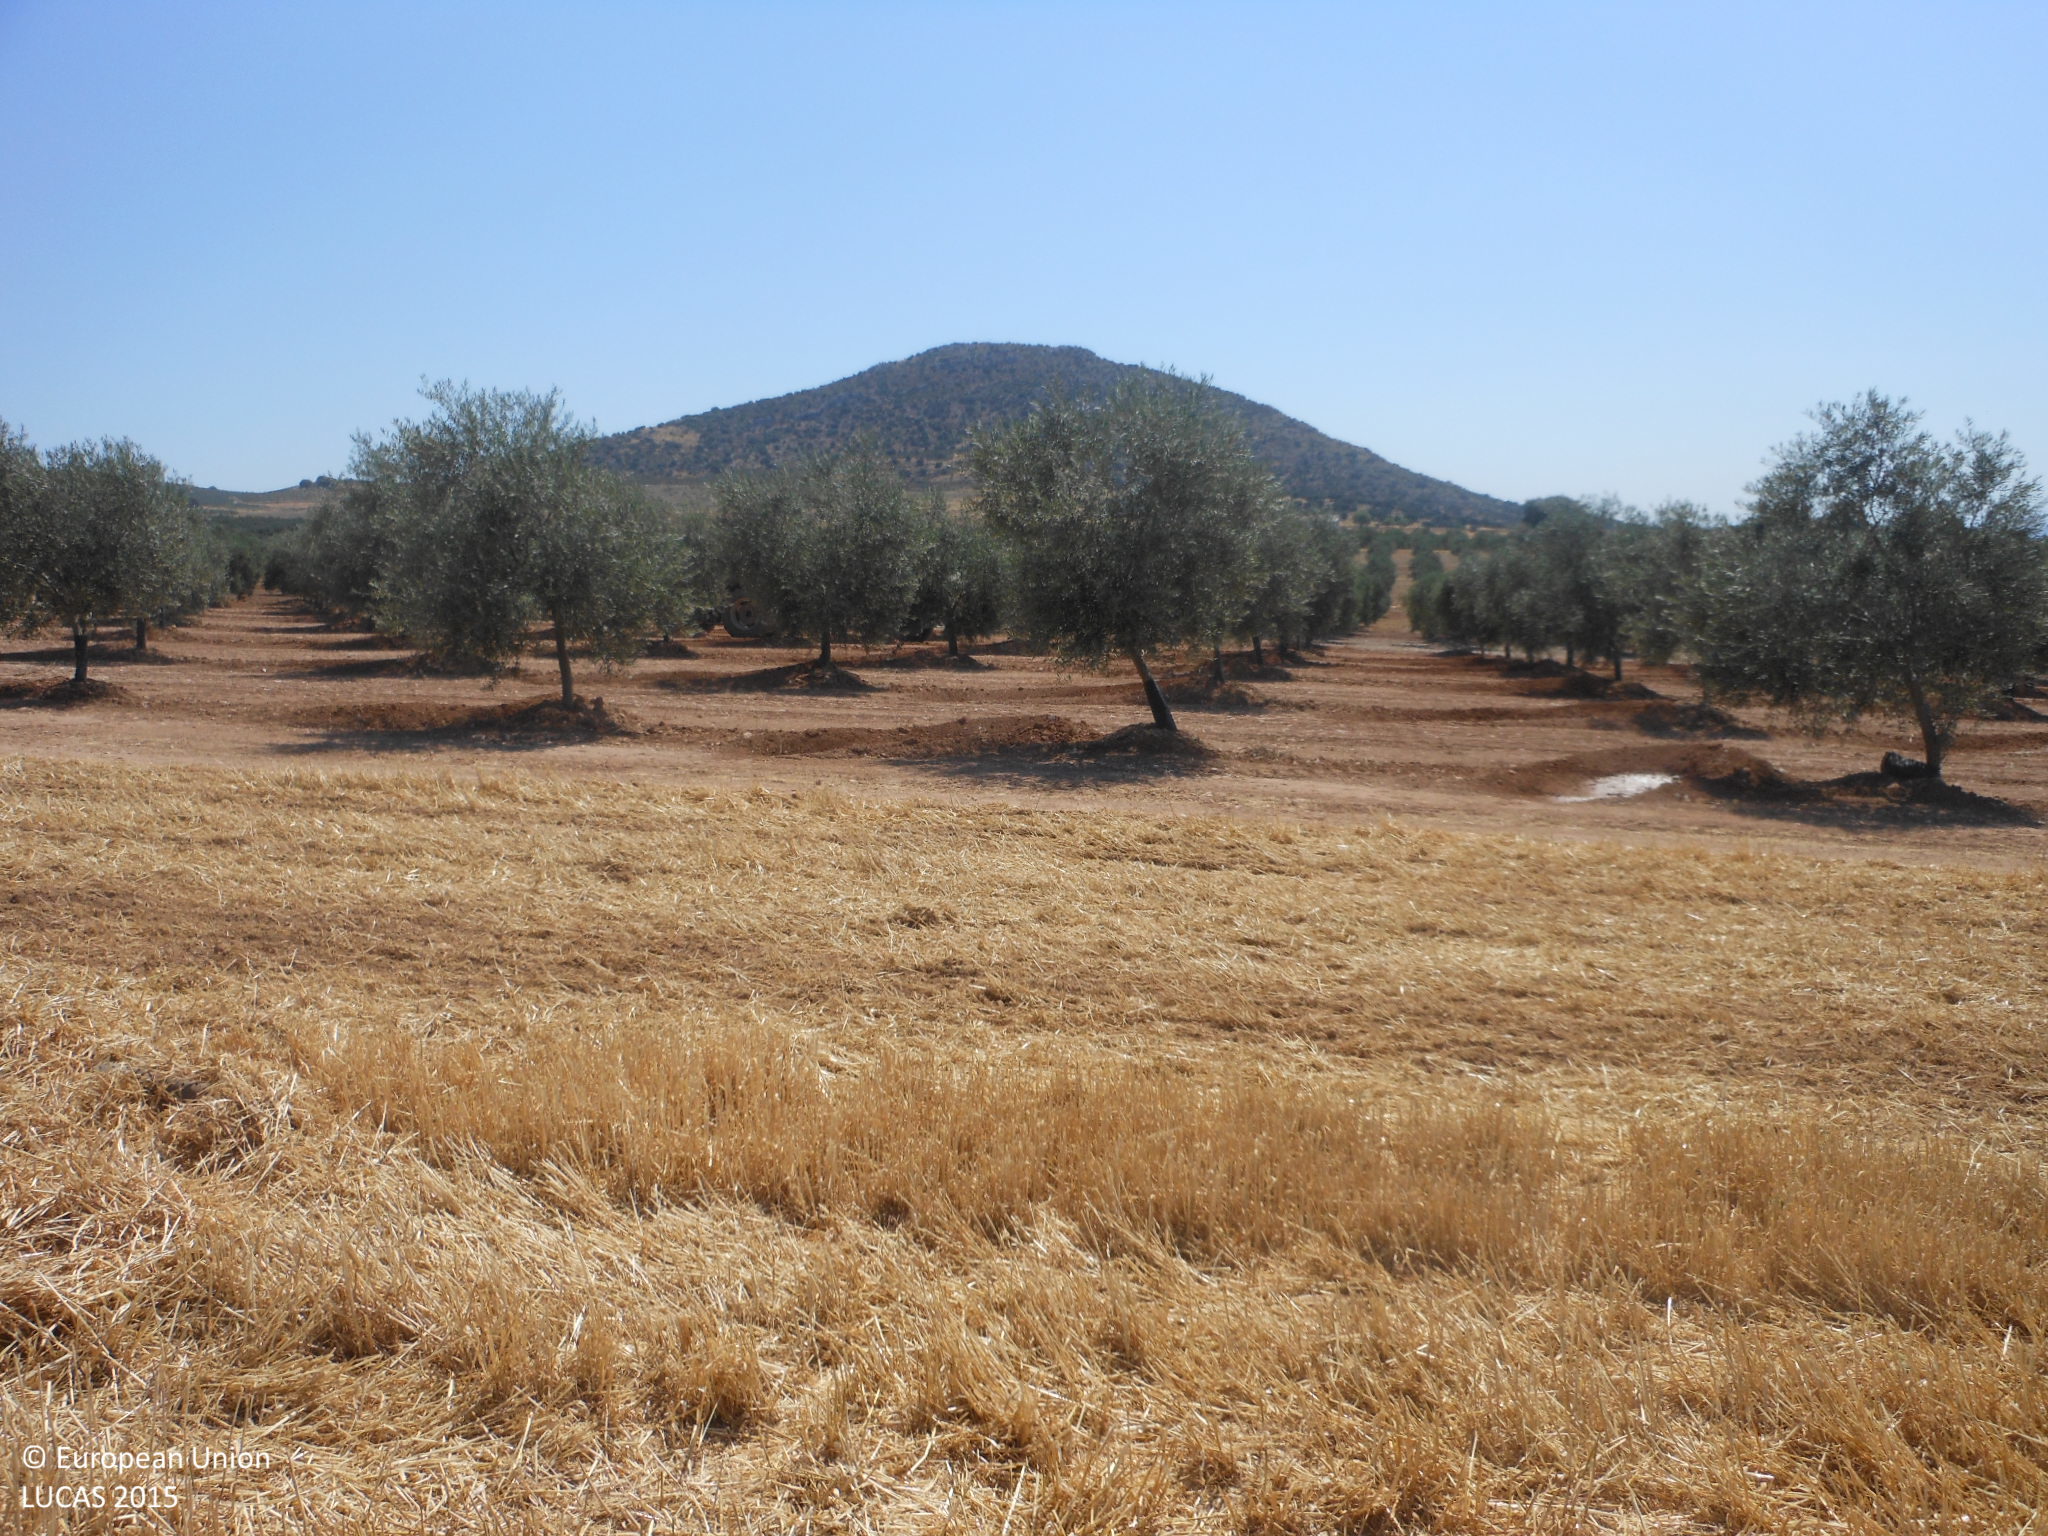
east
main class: Cropland
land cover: Barley
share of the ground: < 10 %
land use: Agriculture (excluding fallow land and kitchen gardens)
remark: Harvested field
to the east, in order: Barley; Olive groves
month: June
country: ES
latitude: 37.2336
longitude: -4.8716
